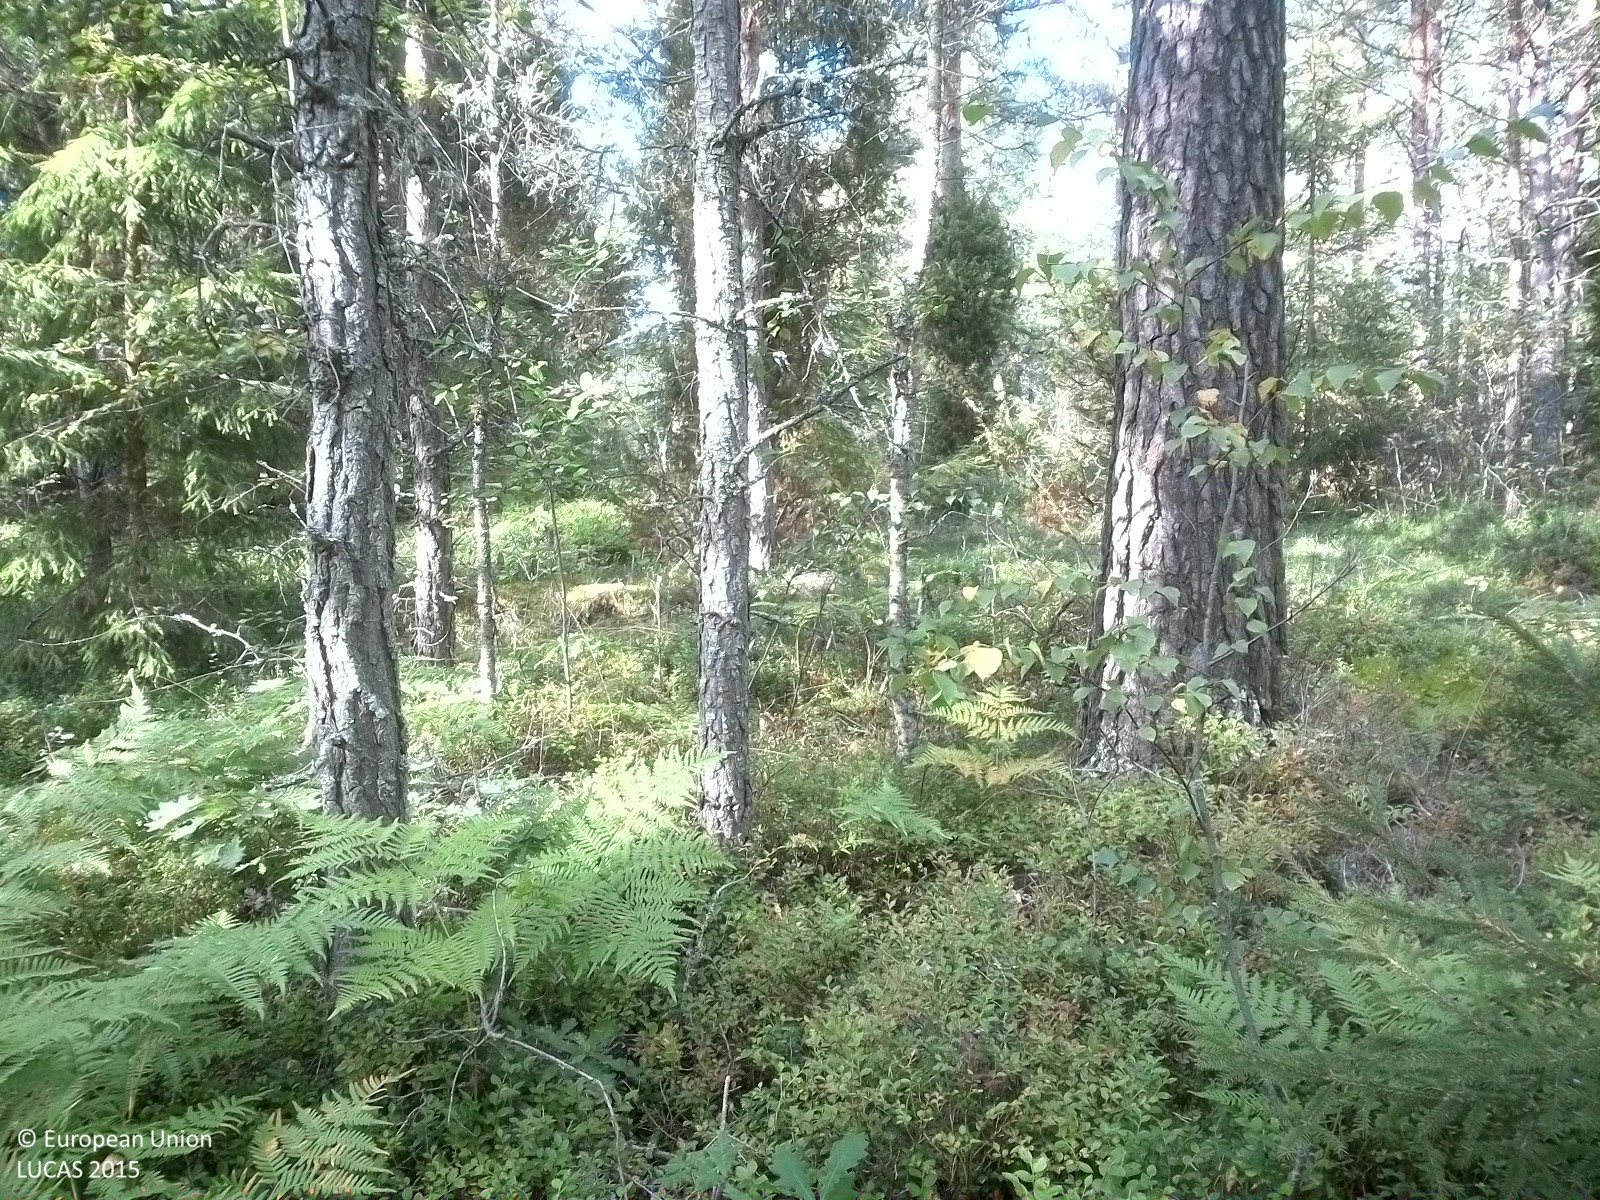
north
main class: Woodland
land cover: Pine dominated mixed woodland
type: boreal forest
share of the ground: 25 - 50 %
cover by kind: herbaceous plants 45 %, coniferous forest trees 25 %, broadleaved forest trees 20 %, lichens and mosses 10 %
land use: Forestry
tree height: > 5 m
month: September
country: SE
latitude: 58.9940
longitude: 15.8584
